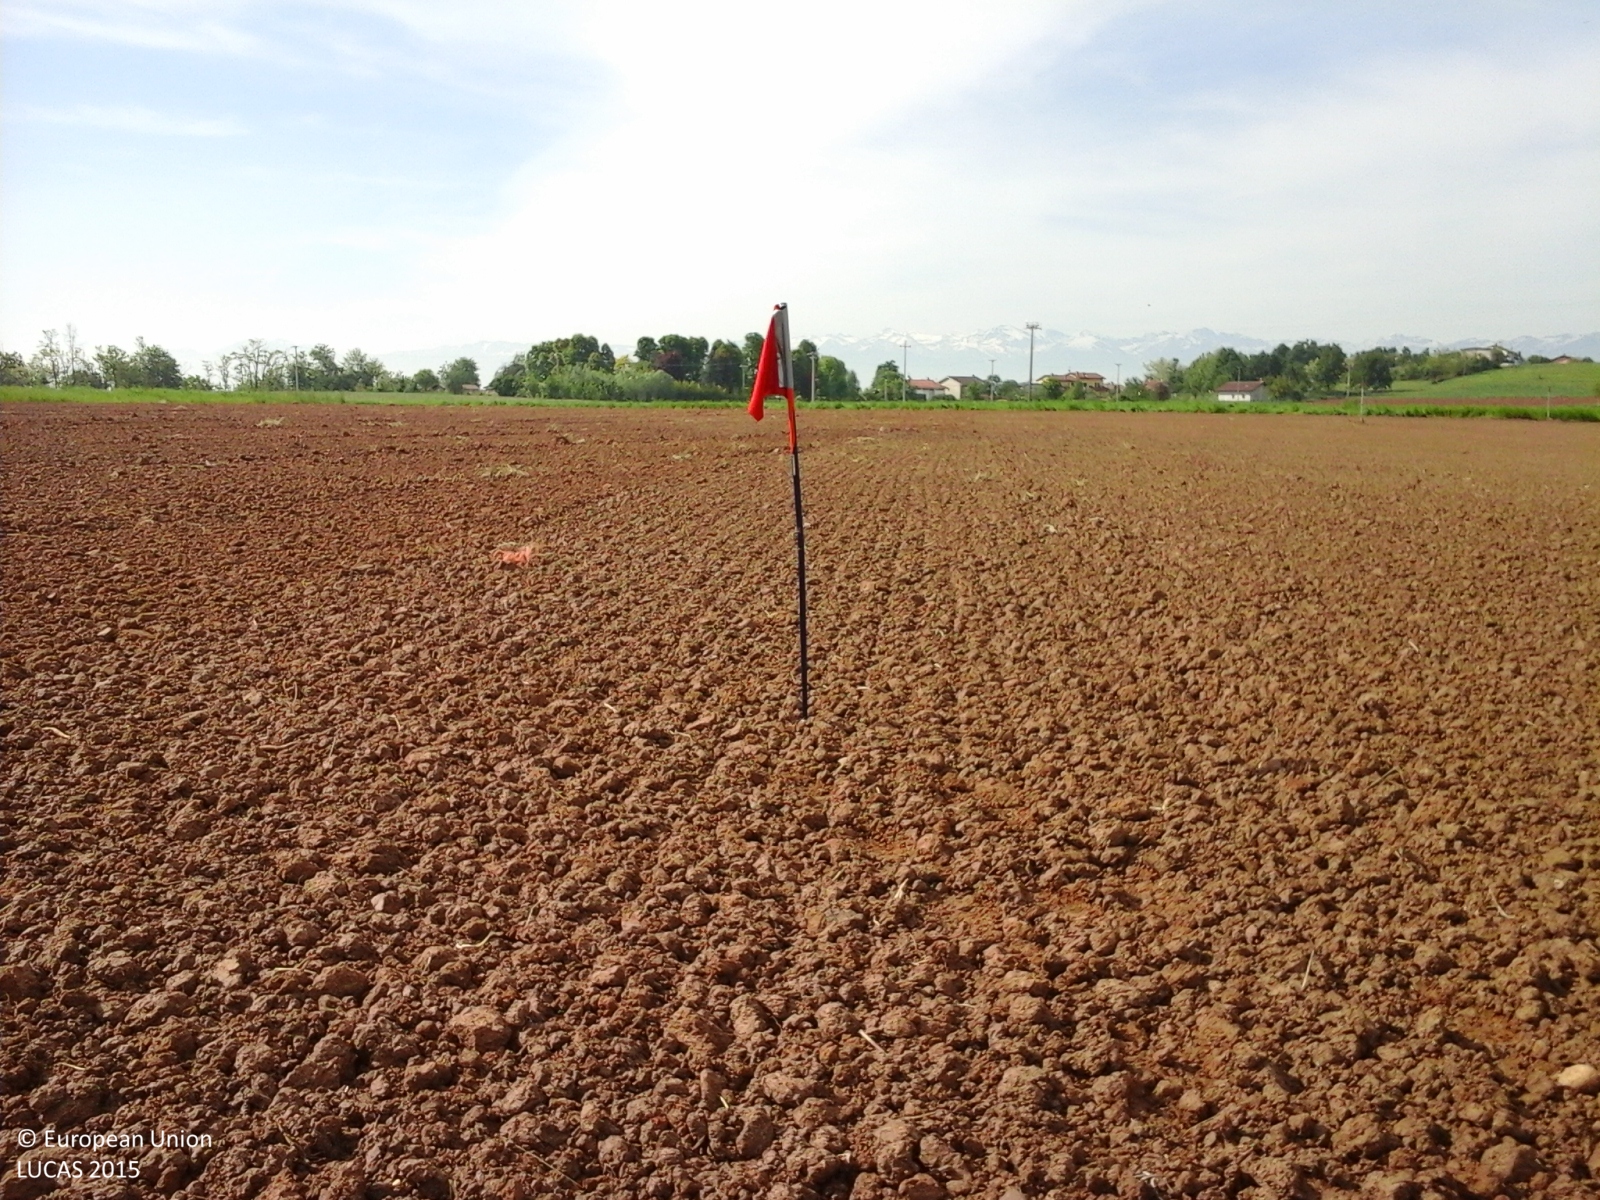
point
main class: Cropland
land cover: Maize
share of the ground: < 10 %
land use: Agriculture (excluding fallow land and kitchen gardens)
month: May
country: IT
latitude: 44.5438
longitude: 7.8019
